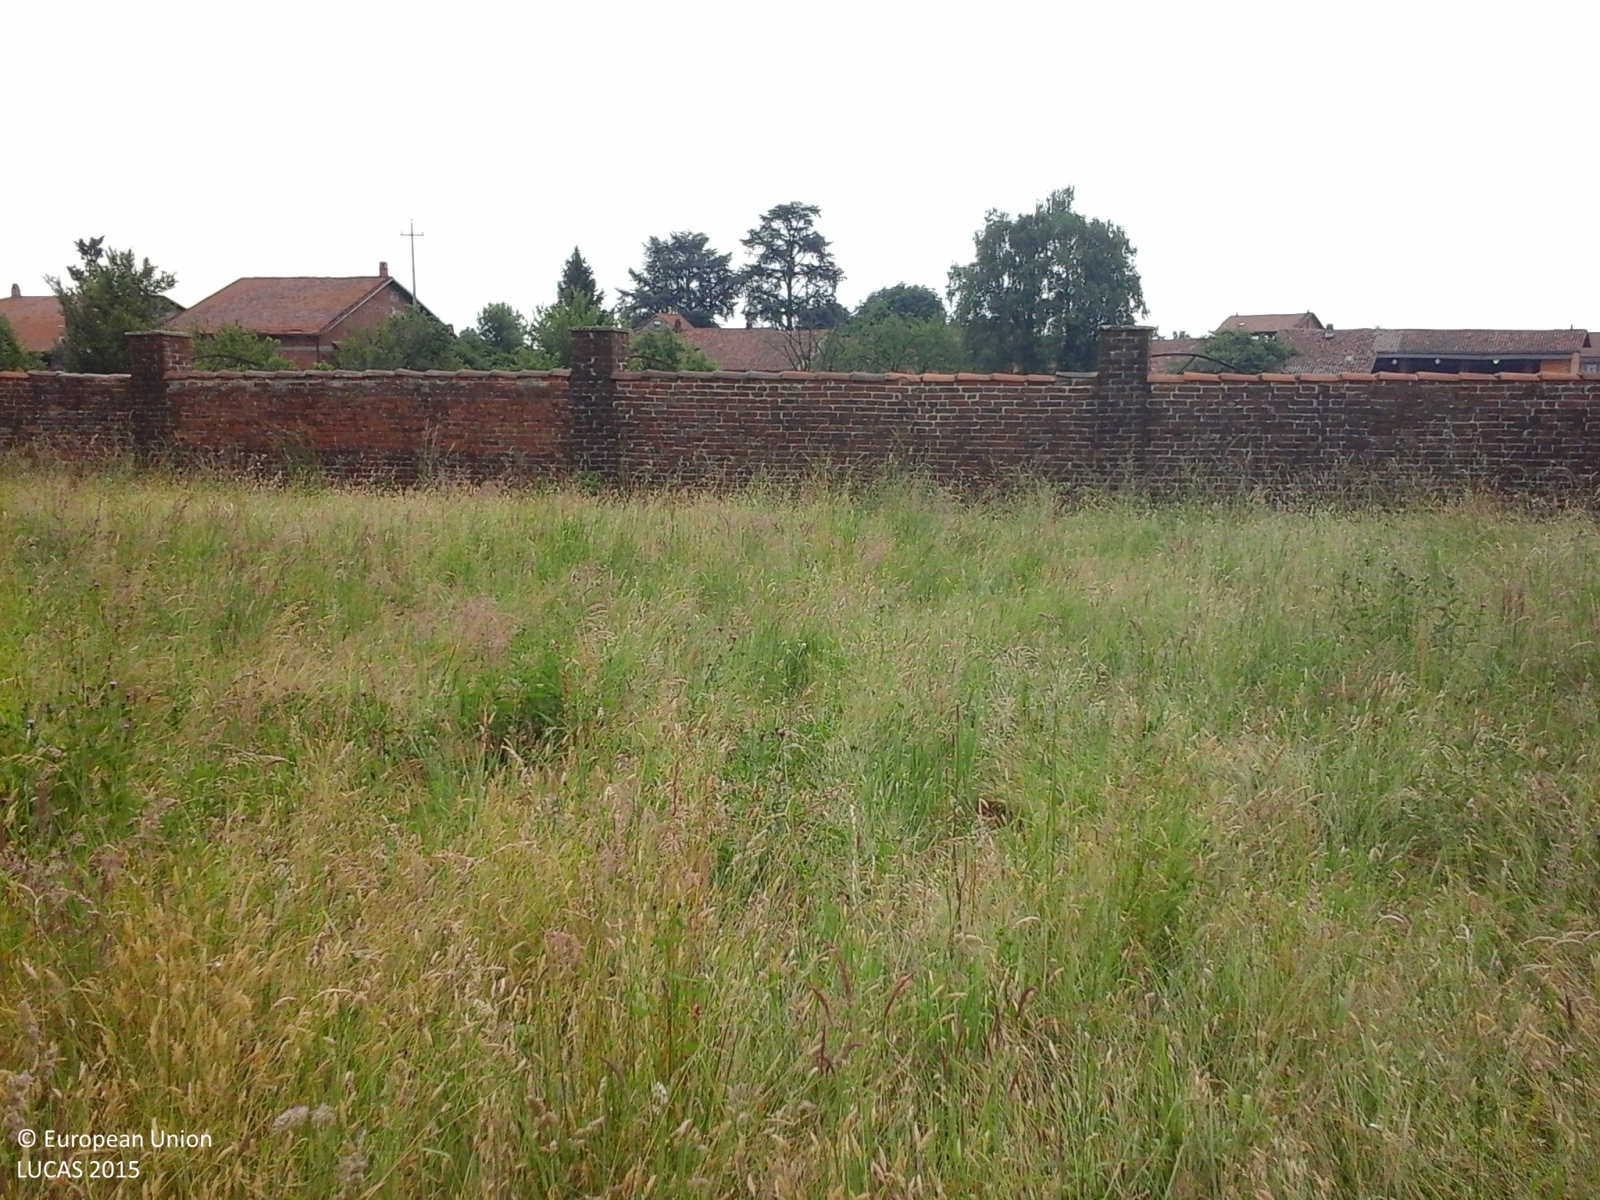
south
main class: Grassland
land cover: Spontaneously vegetated surfaces
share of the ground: > 75 %
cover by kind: herbaceous plants 100 %
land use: Fallow land
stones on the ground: 10 - 25 %
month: May
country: IT
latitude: 45.3525
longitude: 7.6679
